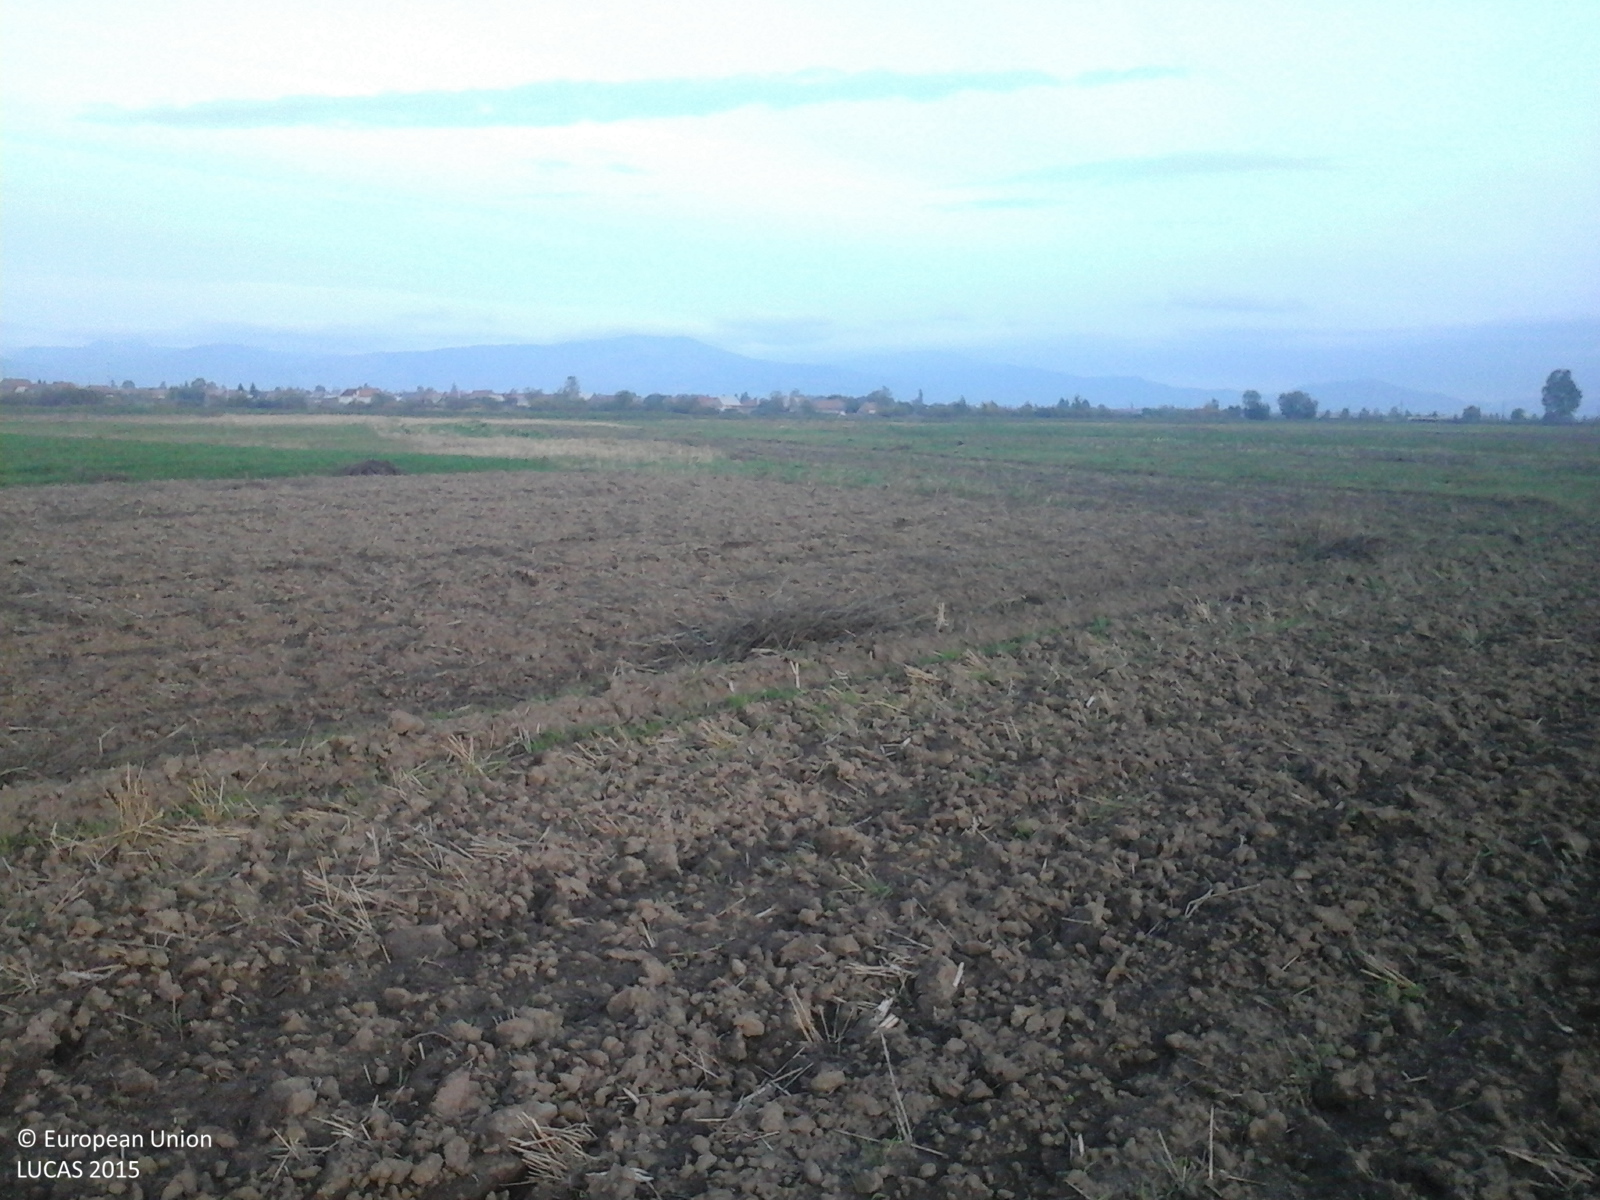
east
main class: Cropland
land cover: Common wheat
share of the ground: < 10 %
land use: Agriculture (excluding fallow land and kitchen gardens)
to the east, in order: Common wheat; Grassland without tree/shrub cover; Tracks; Grassland without tree/shrub cover
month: October
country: RO
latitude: 46.7005
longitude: 25.4768
